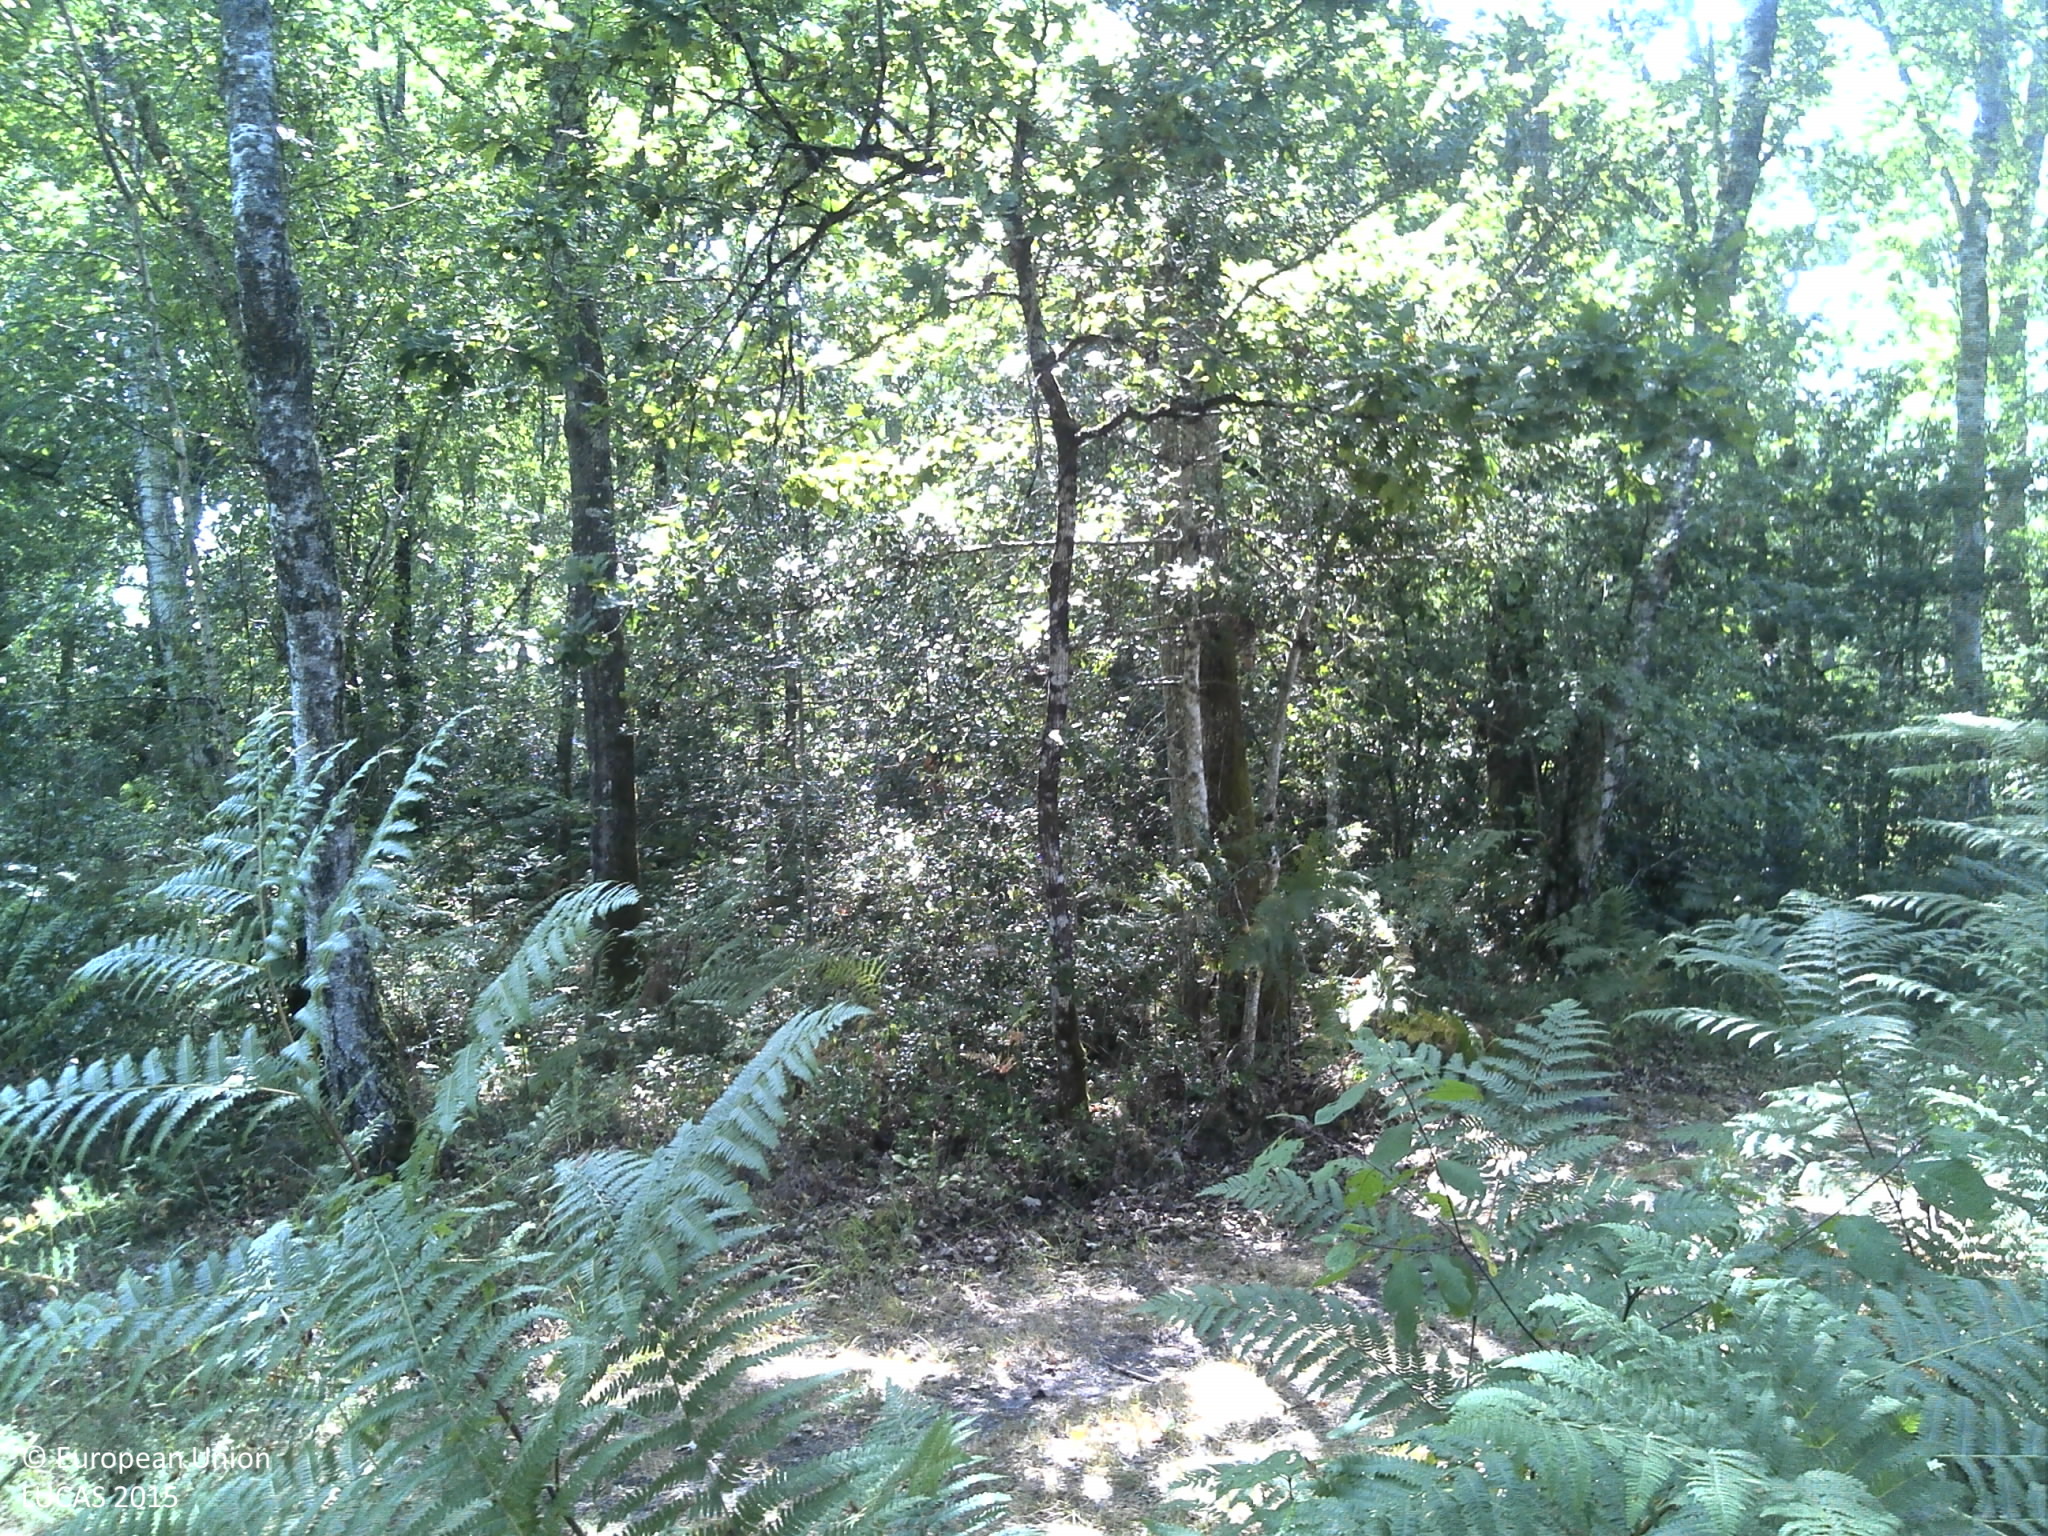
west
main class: Woodland
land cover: Broadleaved woodland
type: acidophilous oak and oak-birch forest
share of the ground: > 75 %
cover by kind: broadleaved forest trees 75 %, shrubs 15 %, herbaceous plants 5 %, lichens and mosses 5 %
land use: Forestry
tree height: > 5 m
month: July
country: FR
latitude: 44.7114
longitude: -0.6340
